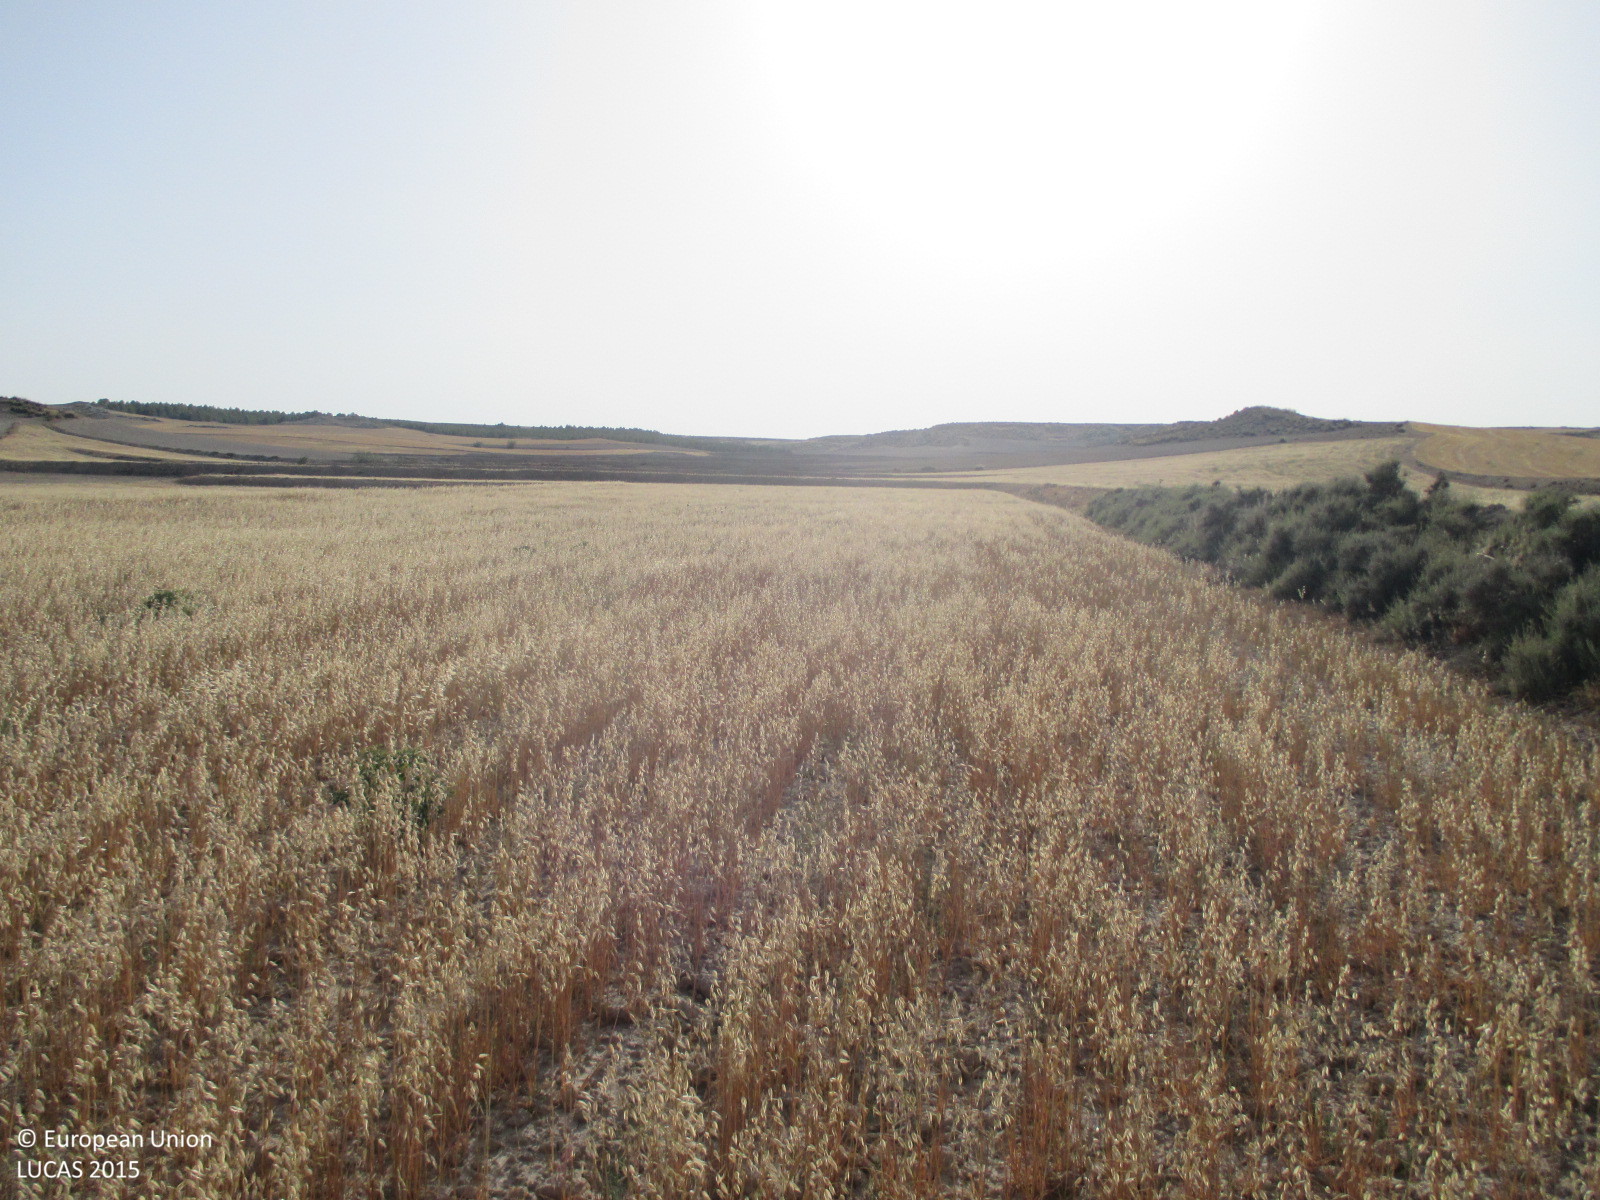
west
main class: Cropland
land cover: Oats
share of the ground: 25 - 50 %
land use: Agriculture (excluding fallow land and kitchen gardens)
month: June
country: ES
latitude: 37.7669
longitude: -2.4647
